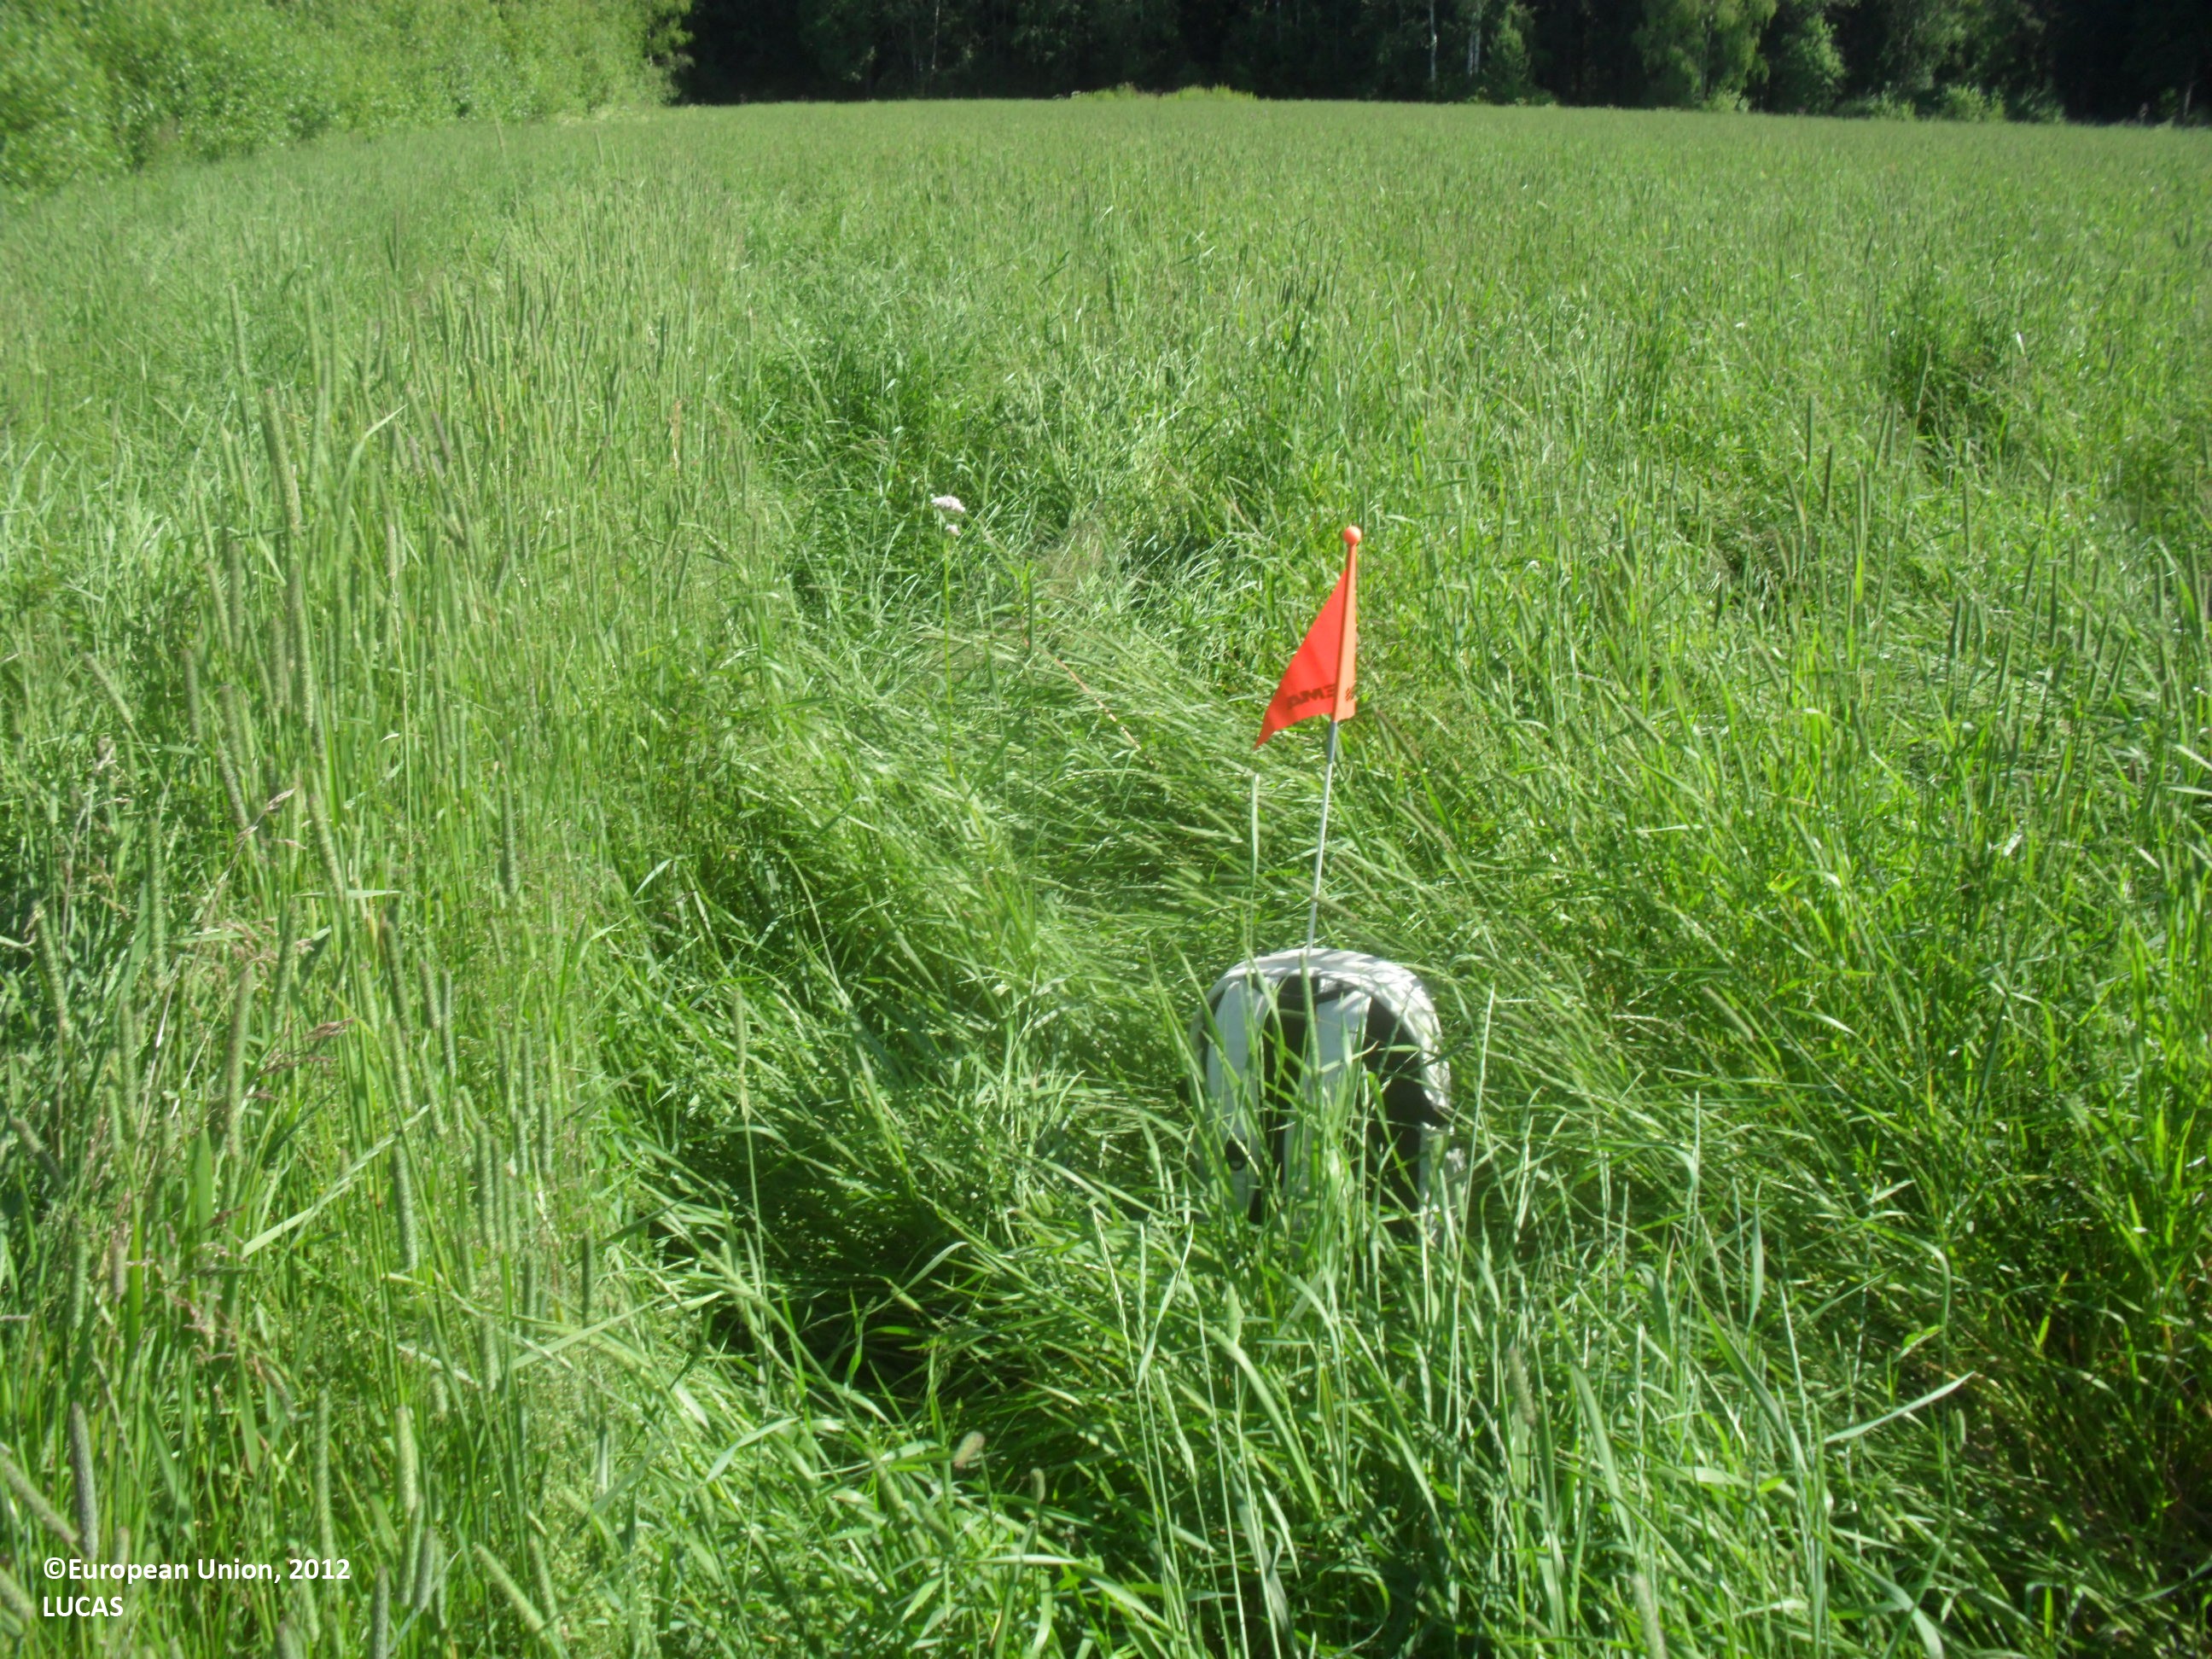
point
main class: Cropland
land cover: Temporary grasslands
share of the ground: > 75 %
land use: Agriculture (excluding fallow land and kitchen gardens)
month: July
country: FI
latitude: 63.1814
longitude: 23.8386
